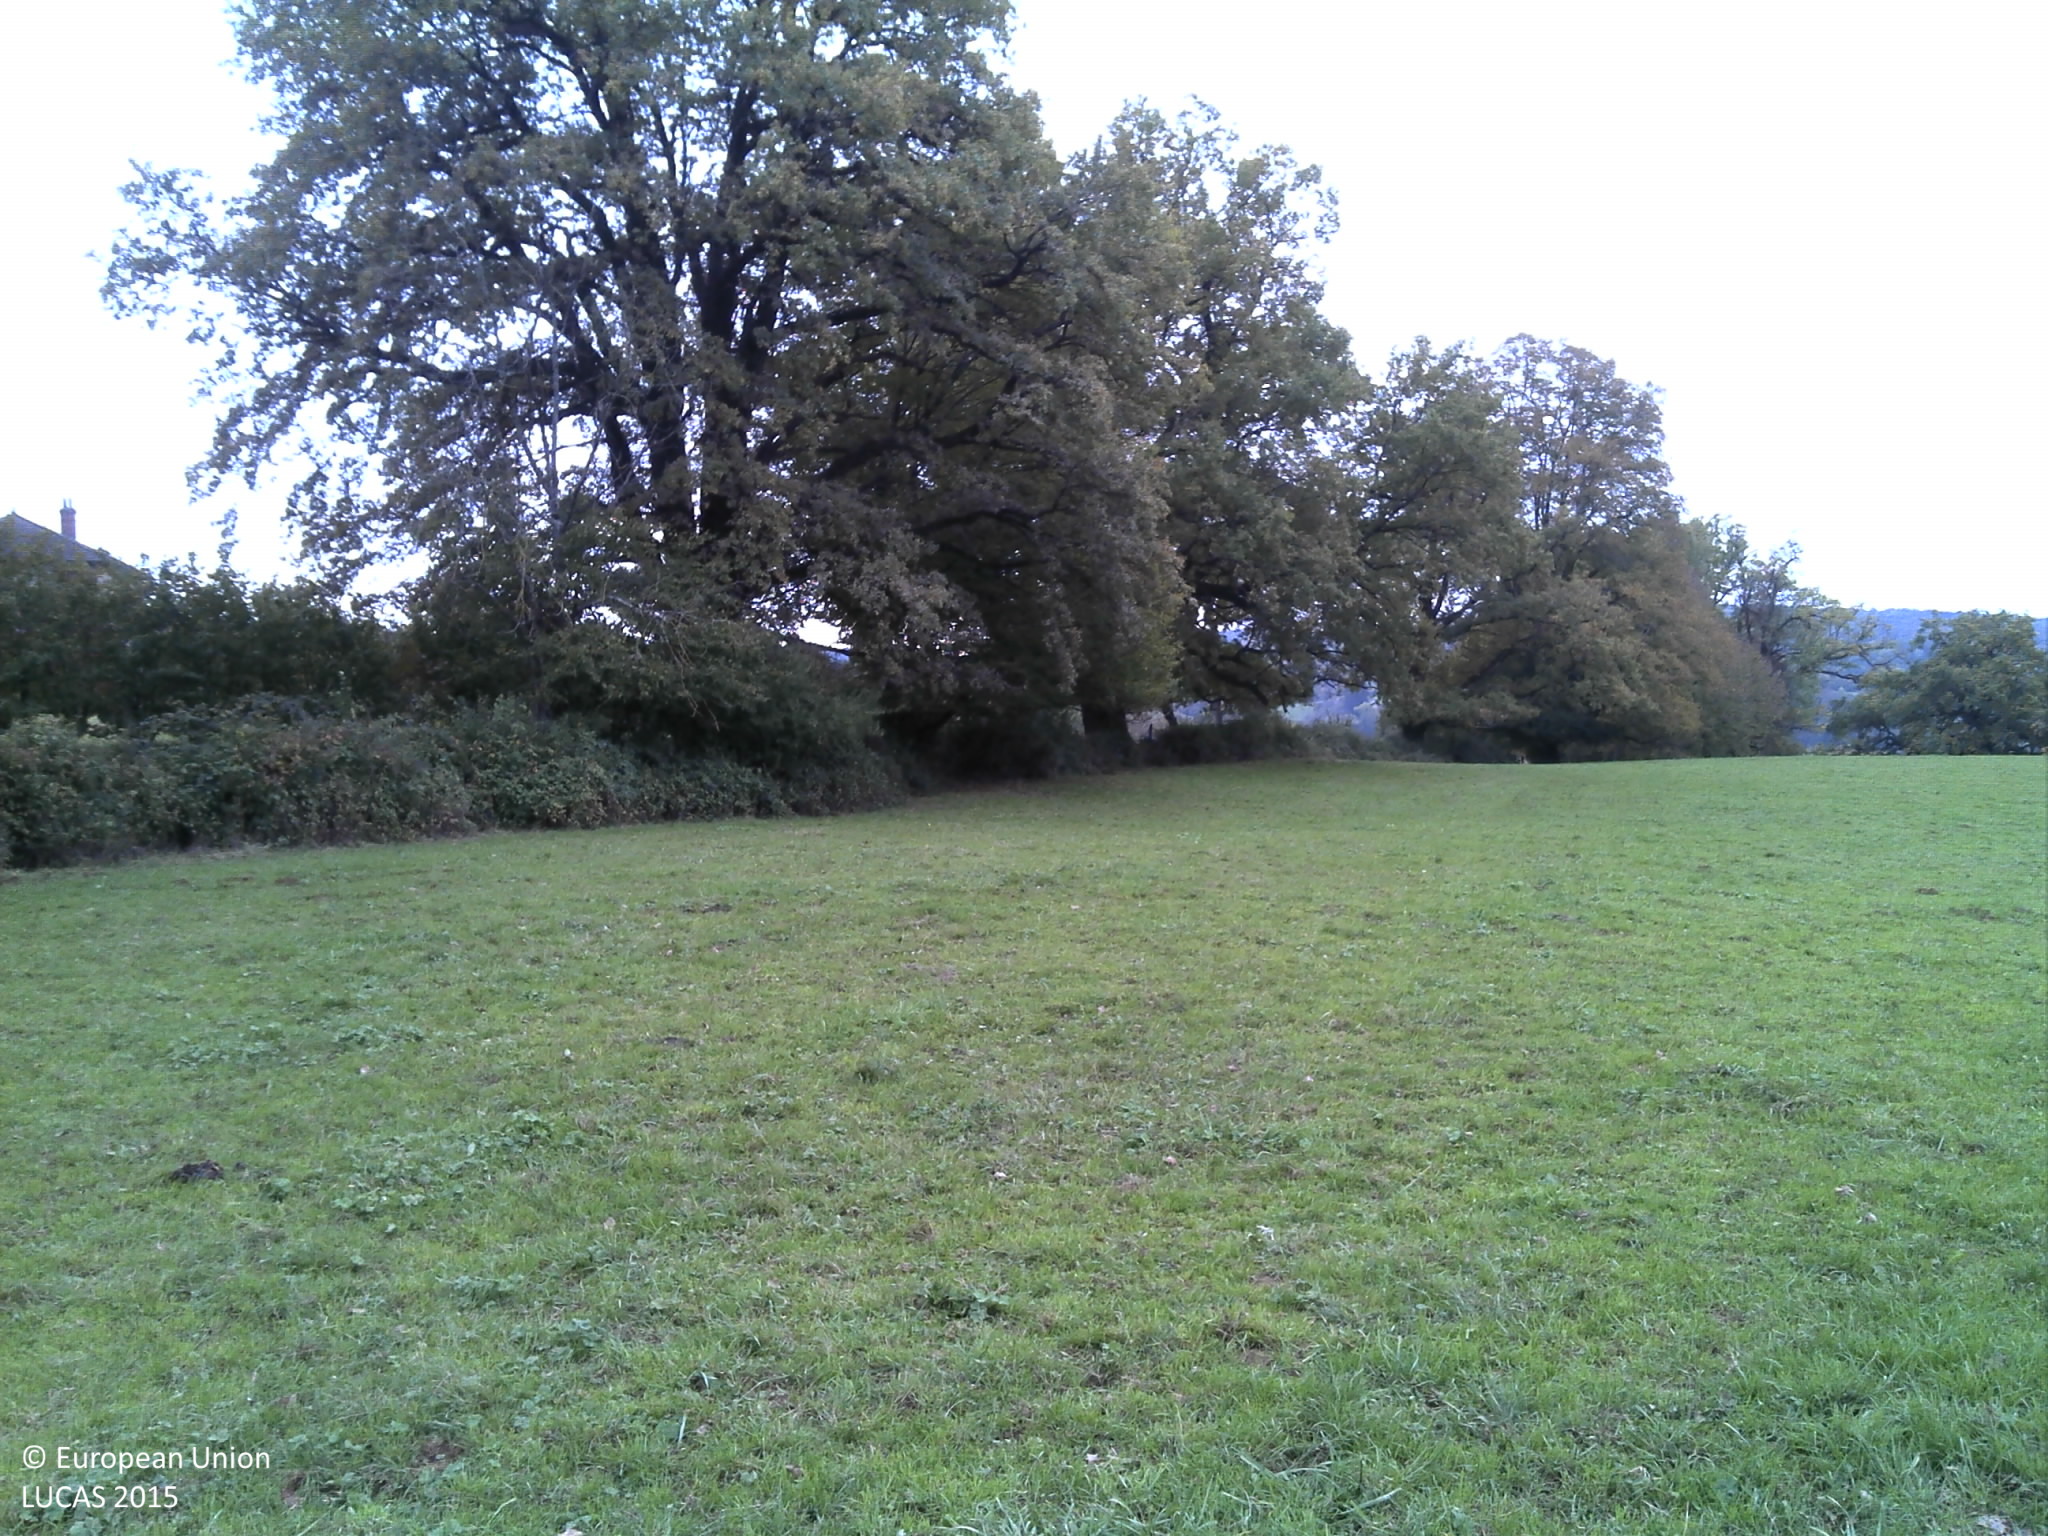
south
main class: Grassland
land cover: Grassland without tree/shrub cover
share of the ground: > 75 %
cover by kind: herbaceous plants 100 %
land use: Agriculture (excluding fallow land and kitchen gardens)
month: October
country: FR
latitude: 46.0904
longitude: 5.4120
